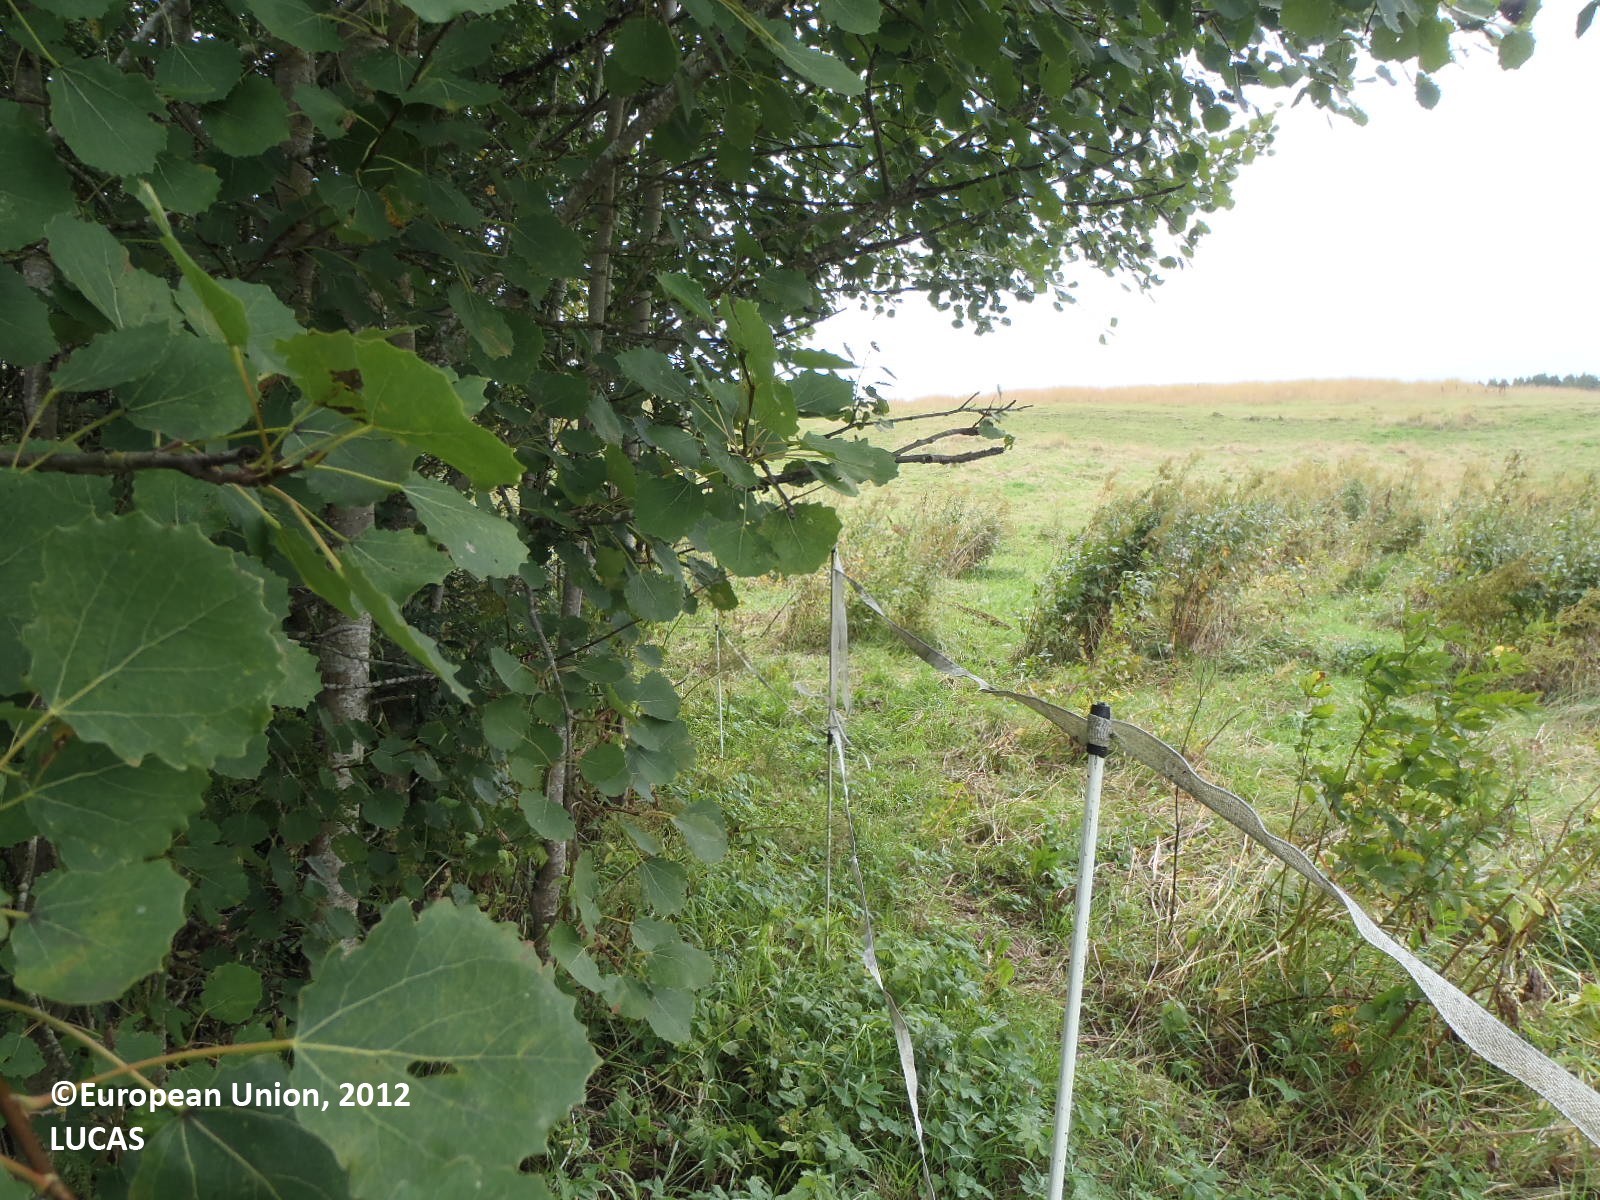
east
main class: Grassland
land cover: Grassland without tree/shrub cover
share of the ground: > 75 %
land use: Agriculture (excluding fallow land and kitchen gardens)
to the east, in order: Grassland without tree/shrub cover; Fences; Grass margins; Ditches and canals; Grassland without tree/shrub cover; Common wheat
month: September
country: FI
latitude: 60.7424
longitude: 22.6353
